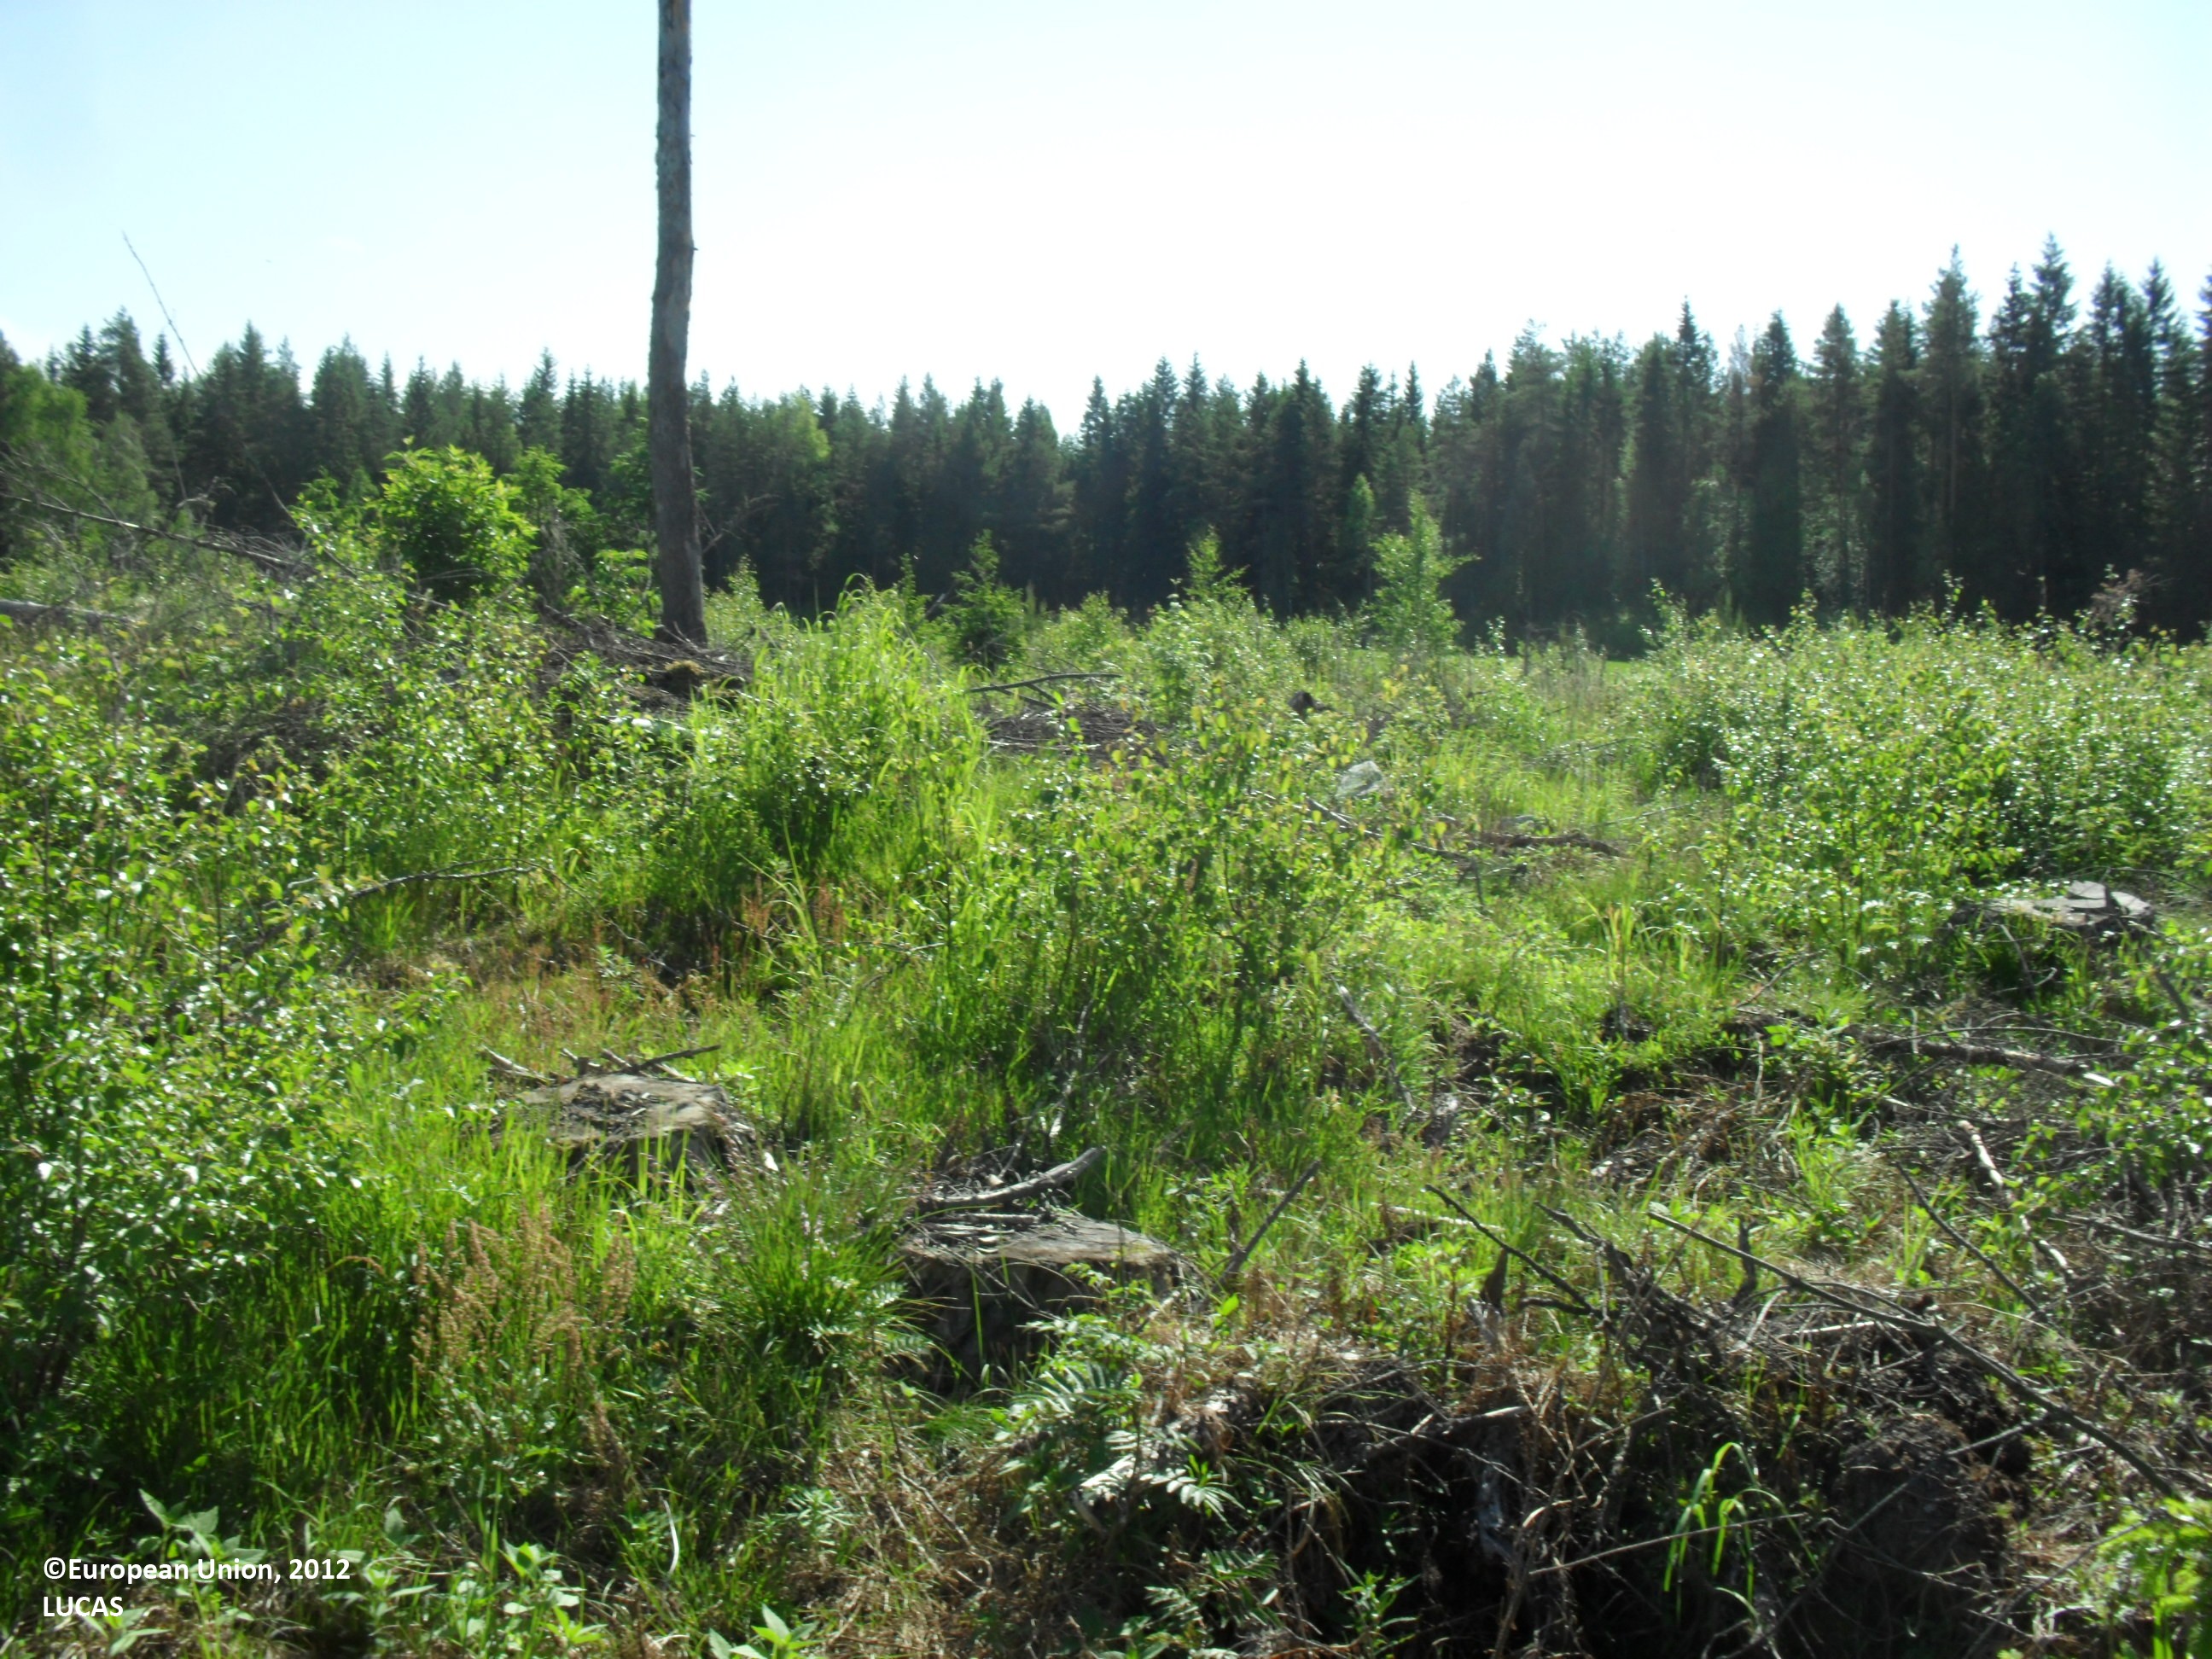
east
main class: Woodland
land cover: Other mixed woodland
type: boreal forest
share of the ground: 10 - 25 %
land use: Forestry
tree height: < 5 m
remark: Clear cut
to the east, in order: Other mixed woodland; Grassland with sparse tree/shrub cover; Ditches and canals; Lines of trees; Barley; Ditches and canals; Spruce dominated coniferous woodland; Pine dominated coniferous woodland; Other coniferous woodland
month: June
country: FI
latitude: 62.9542
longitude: 23.0907
